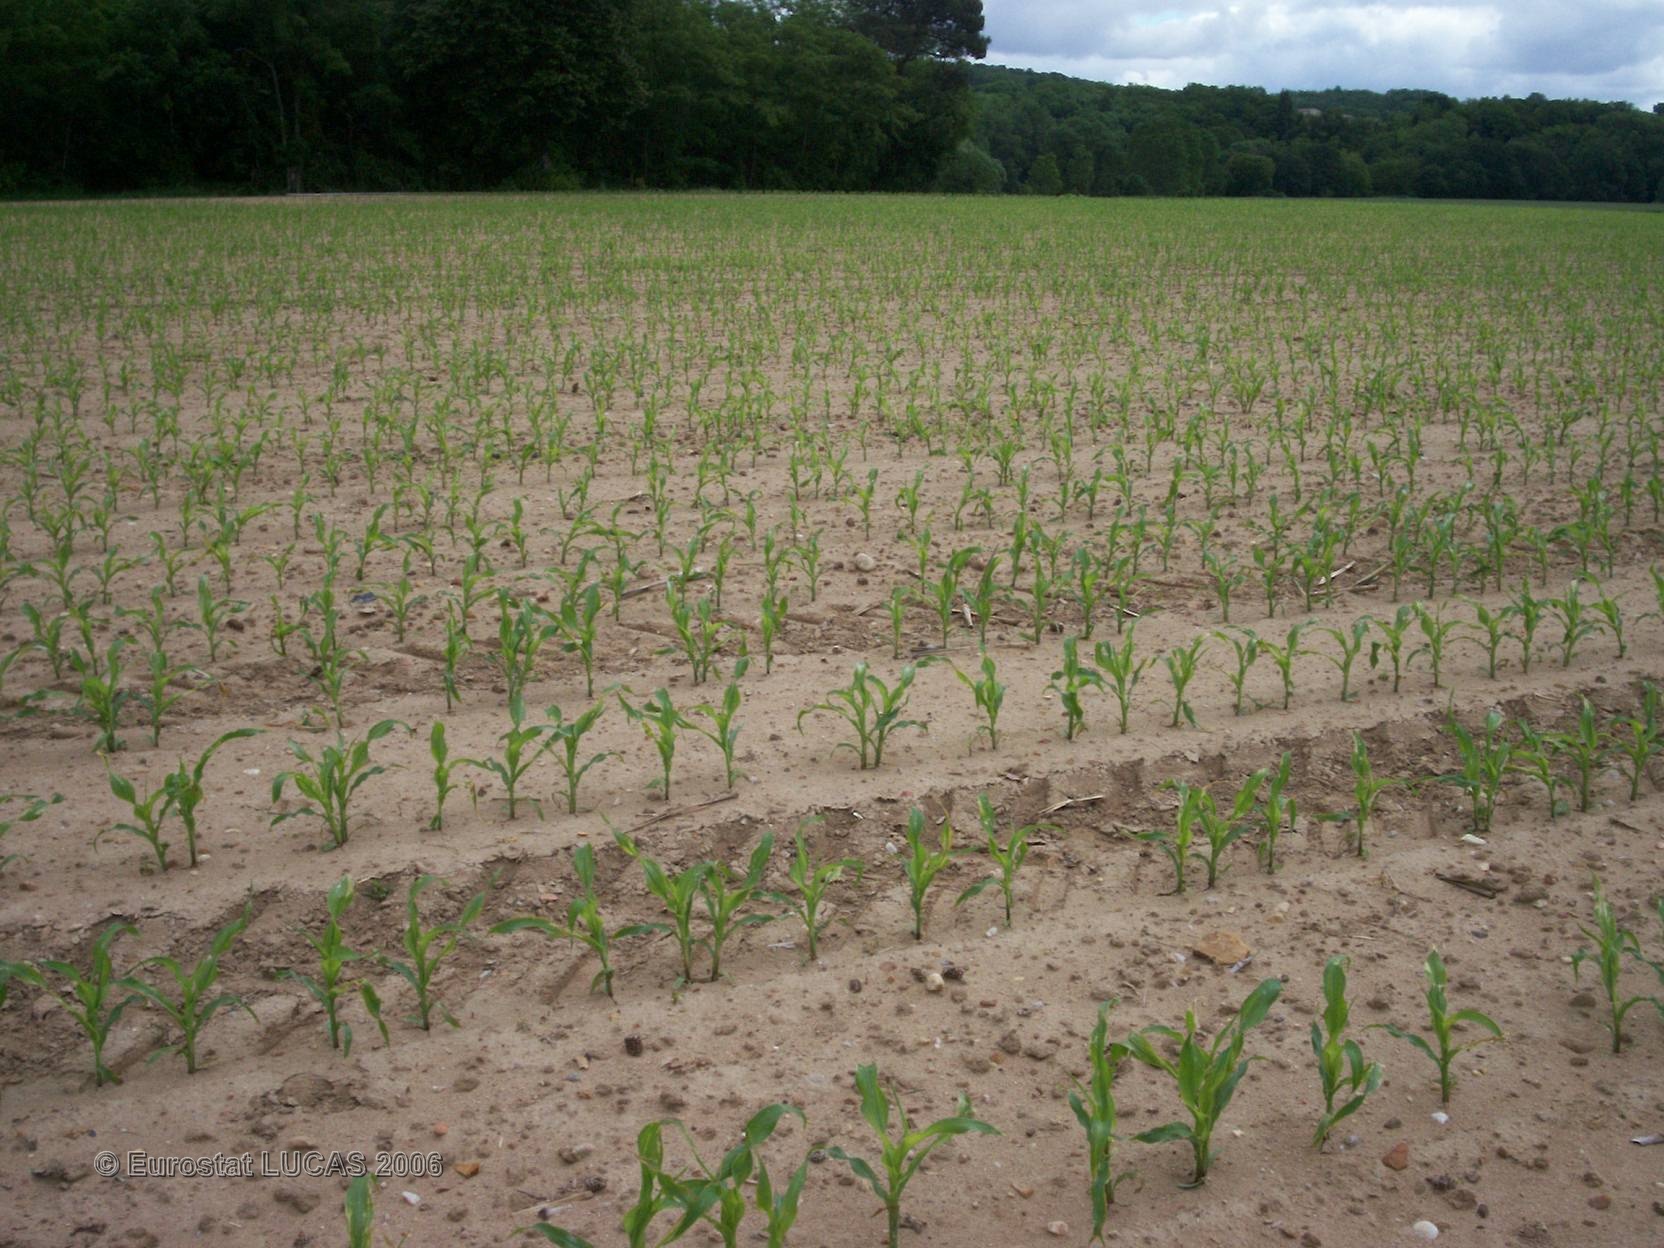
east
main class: Cropland
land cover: Maize
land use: Agriculture (excluding fallow land and kitchen gardens)
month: May
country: FR
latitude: 46.7115
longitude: 0.5507
